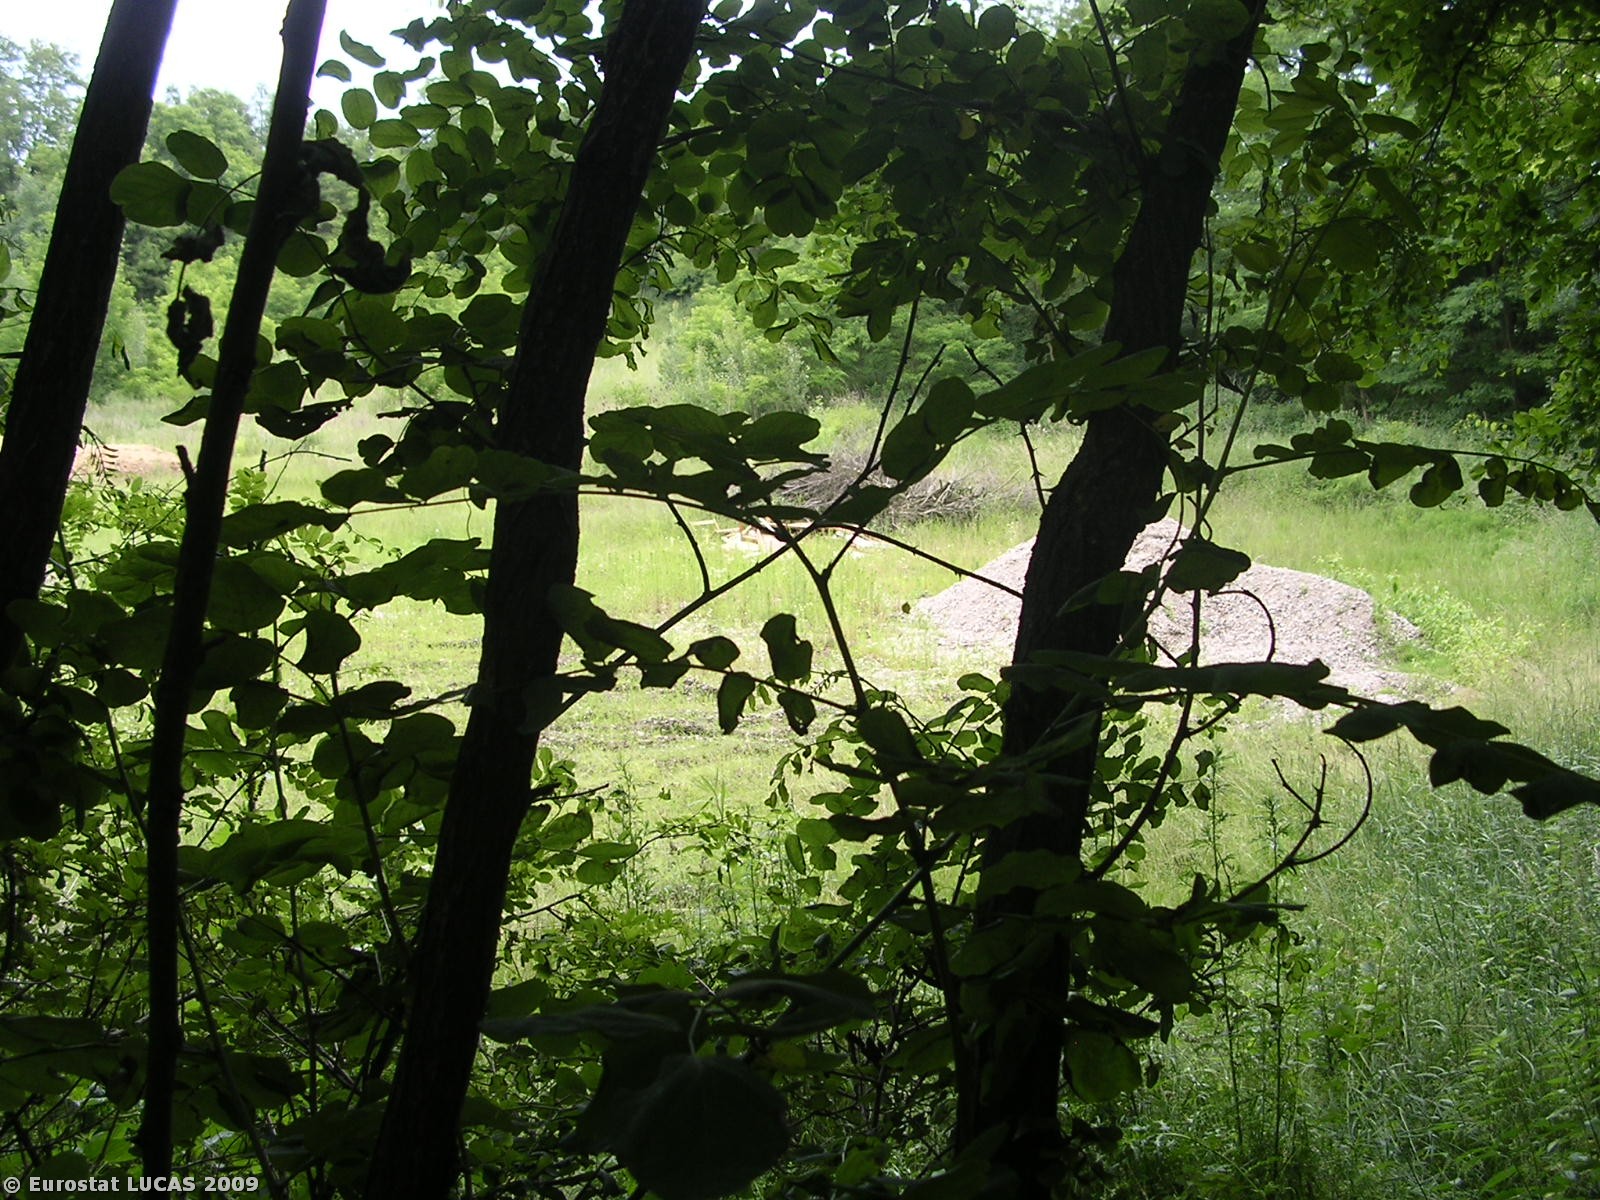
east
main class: Woodland
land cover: Broadleaved woodland
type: plantations and self-sown exotic forest
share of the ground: > 75 %
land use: Unused
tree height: > 5 m
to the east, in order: Broadleaved woodland; Grassland without tree/shrub cover; Grassland with sparse tree/shrub cover; Broadleaved woodland; Fences; Artificial constructions in urban areas
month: June
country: CZ
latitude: 50.5091
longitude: 14.9522
